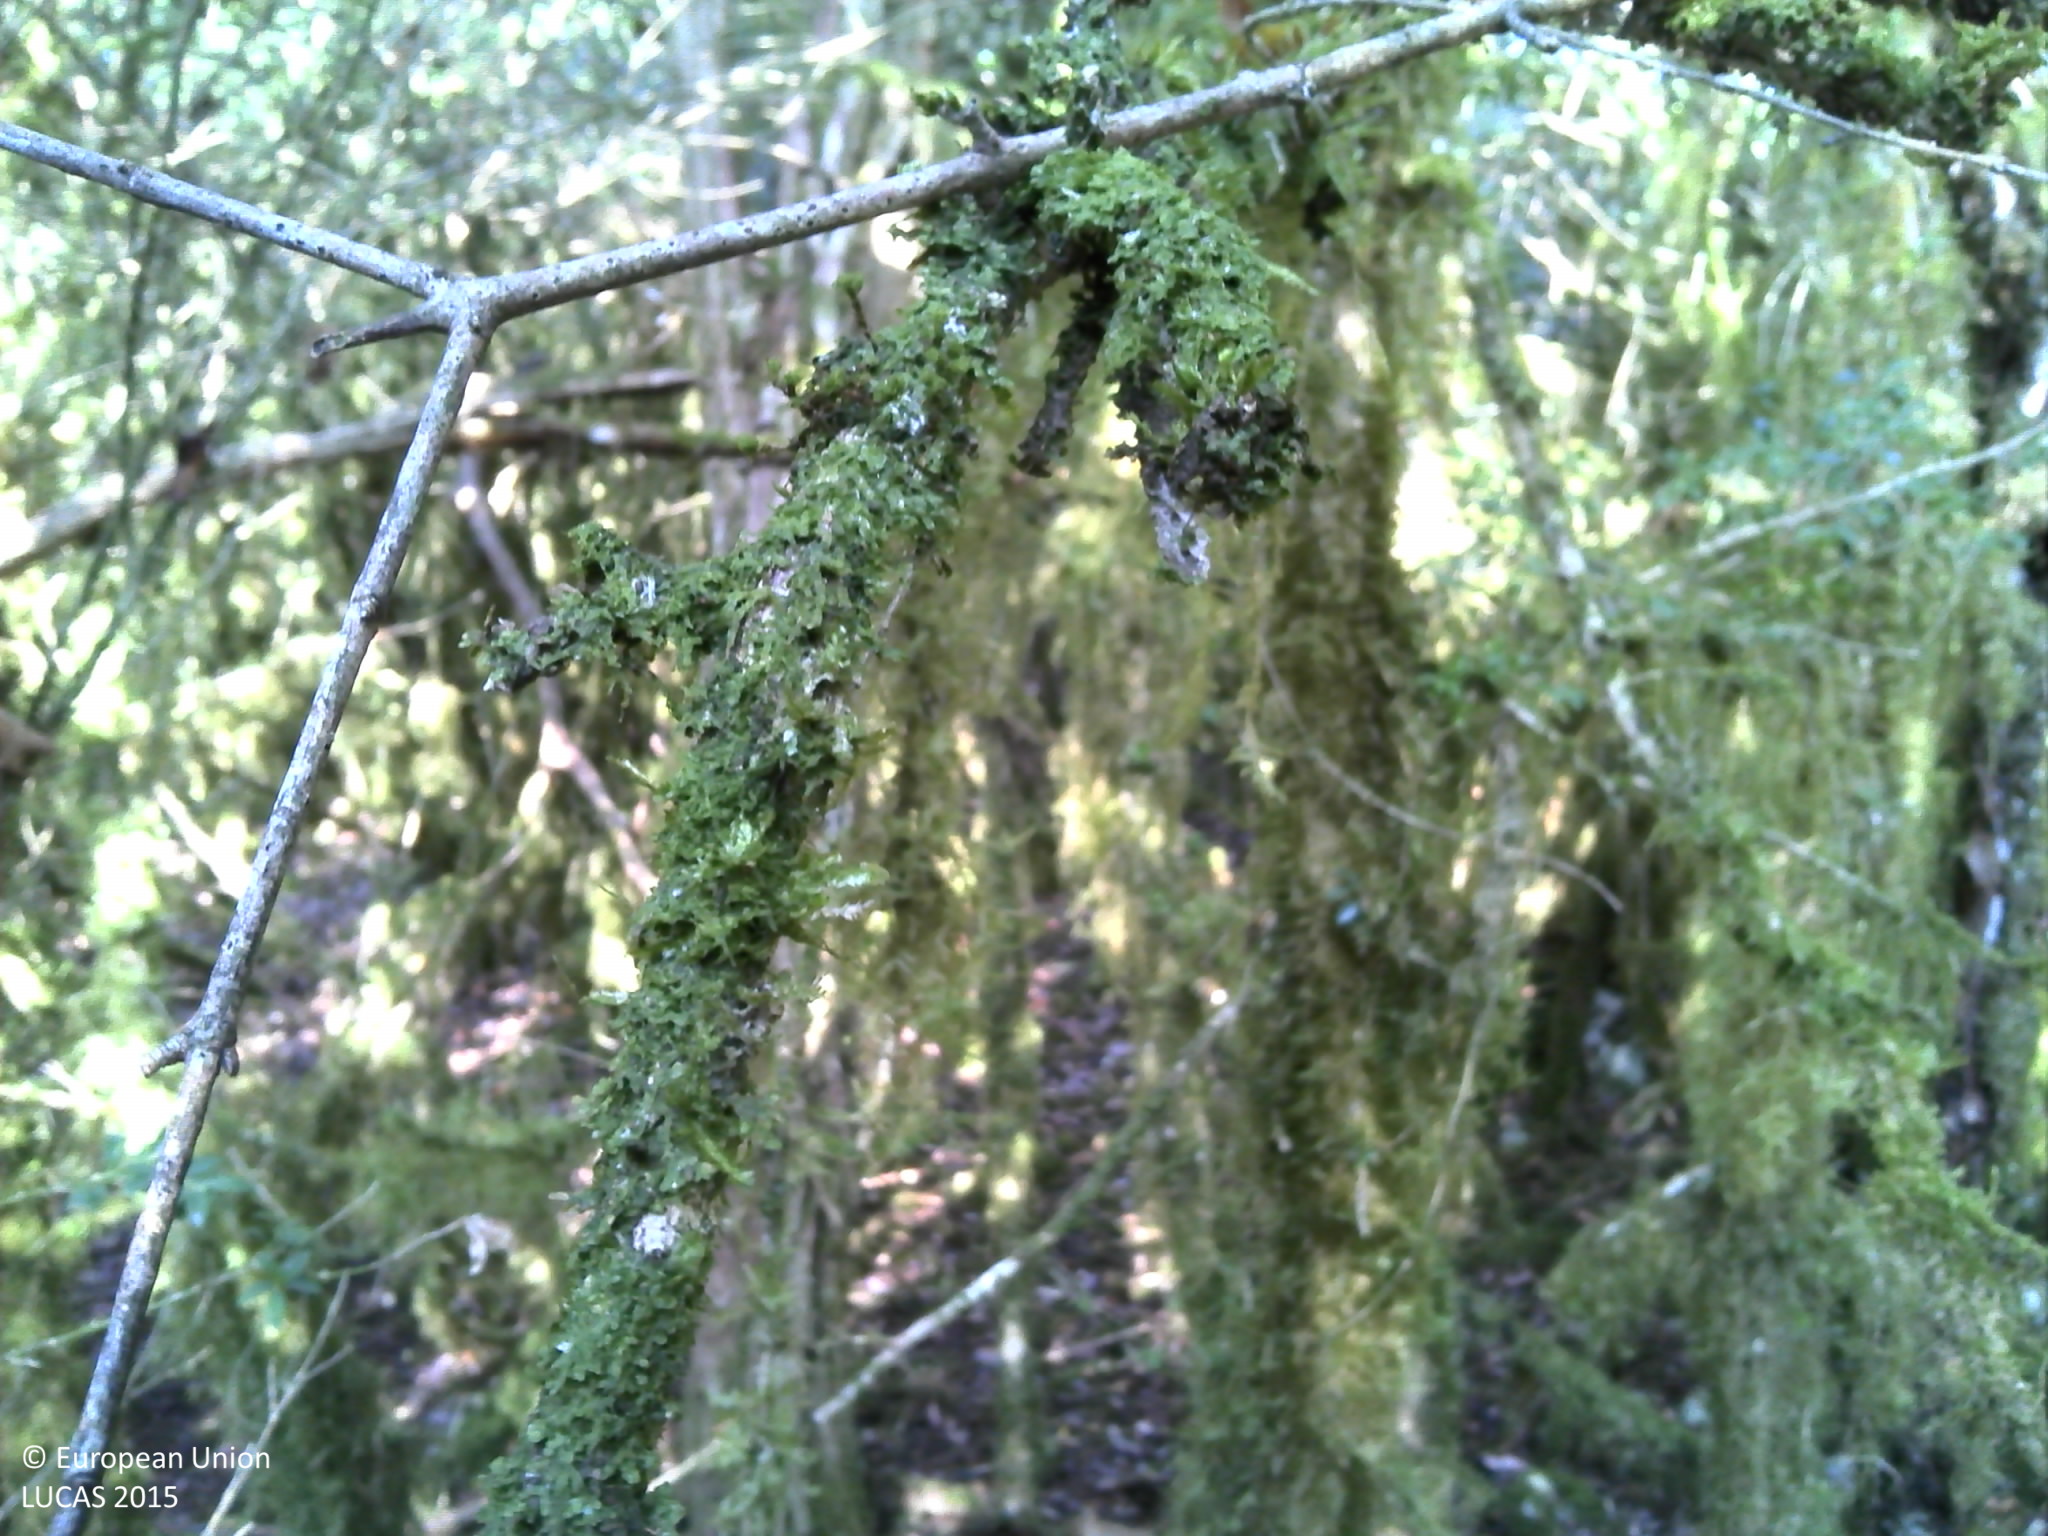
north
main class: Woodland
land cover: Broadleaved woodland
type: mesophytic deciduous forest
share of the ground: > 75 %
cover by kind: broadleaved forest trees 90 %, consolidated bare surface 5 %, unconsolidated bare surface 5 %
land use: Semi-natural and natural areas not in use
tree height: > 5 m
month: October
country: FR
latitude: 46.1623
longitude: 5.4058
